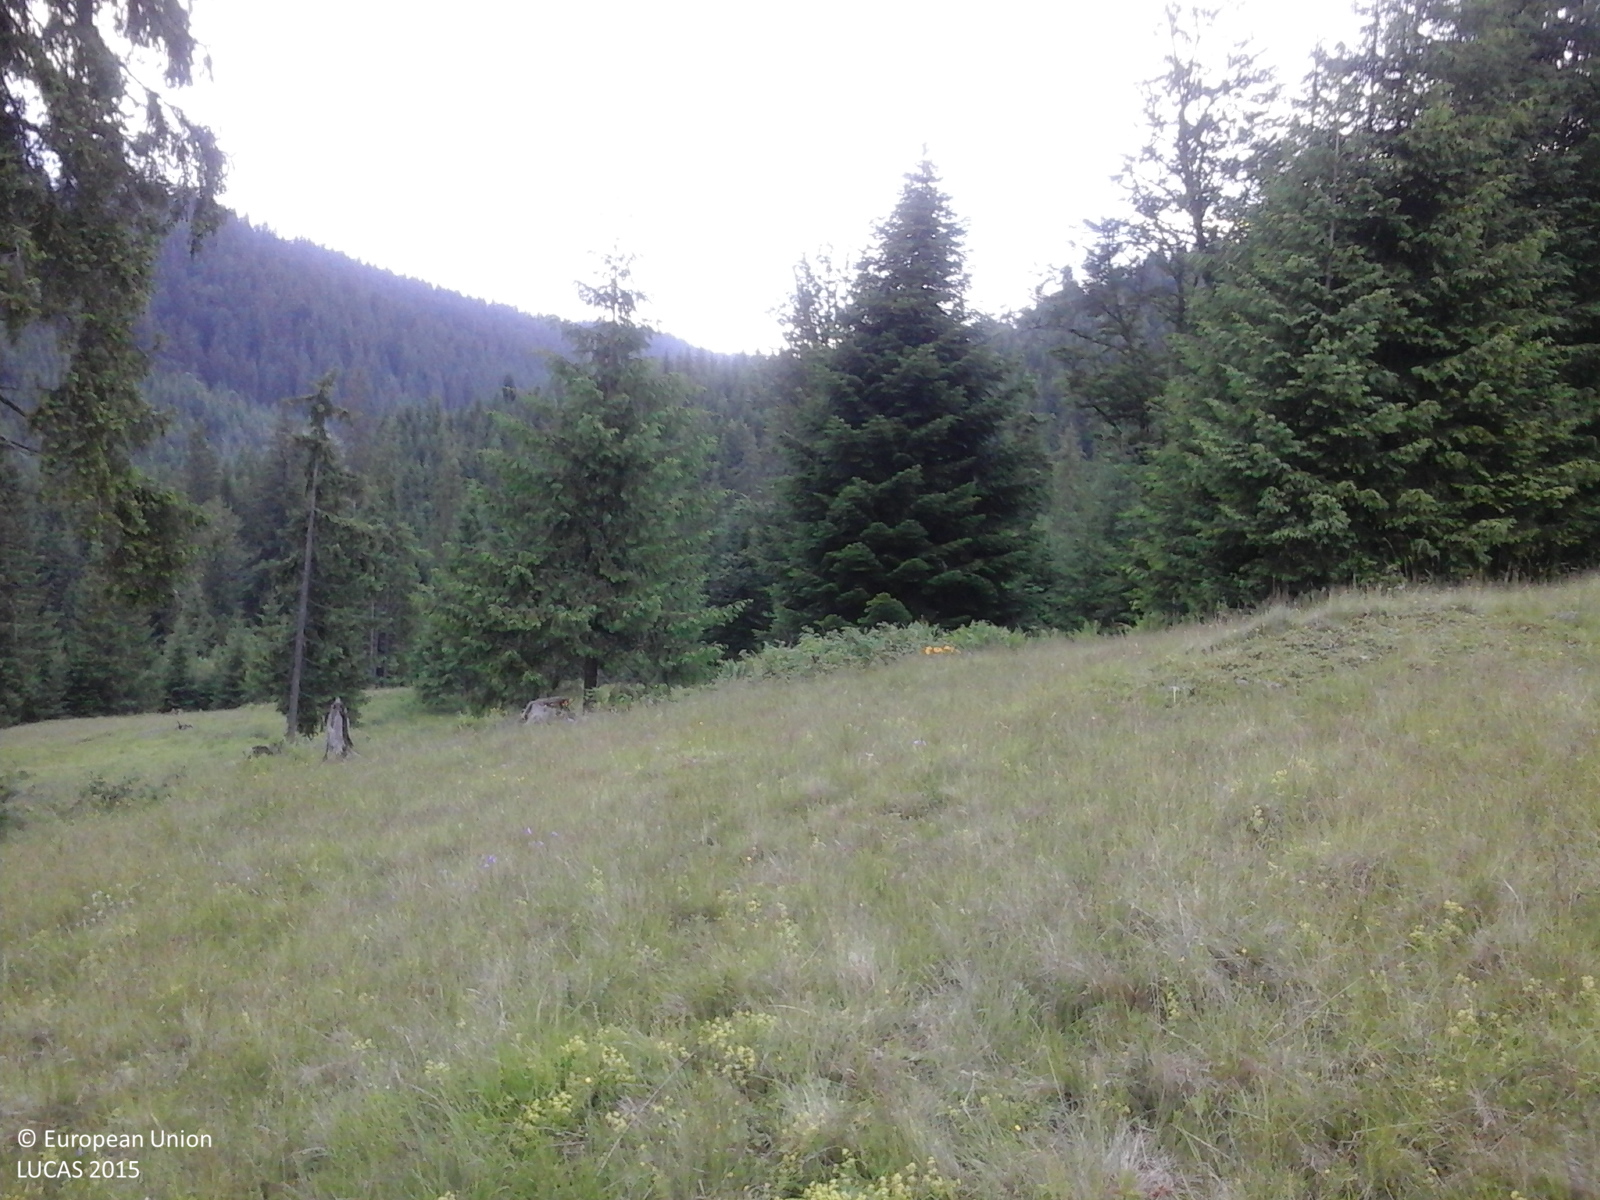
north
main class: Grassland
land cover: Grassland without tree/shrub cover
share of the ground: > 75 %
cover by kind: herbaceous plants 100 %
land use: Agriculture (excluding fallow land and kitchen gardens)
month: June
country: RO
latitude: 47.3754
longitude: 25.1115
